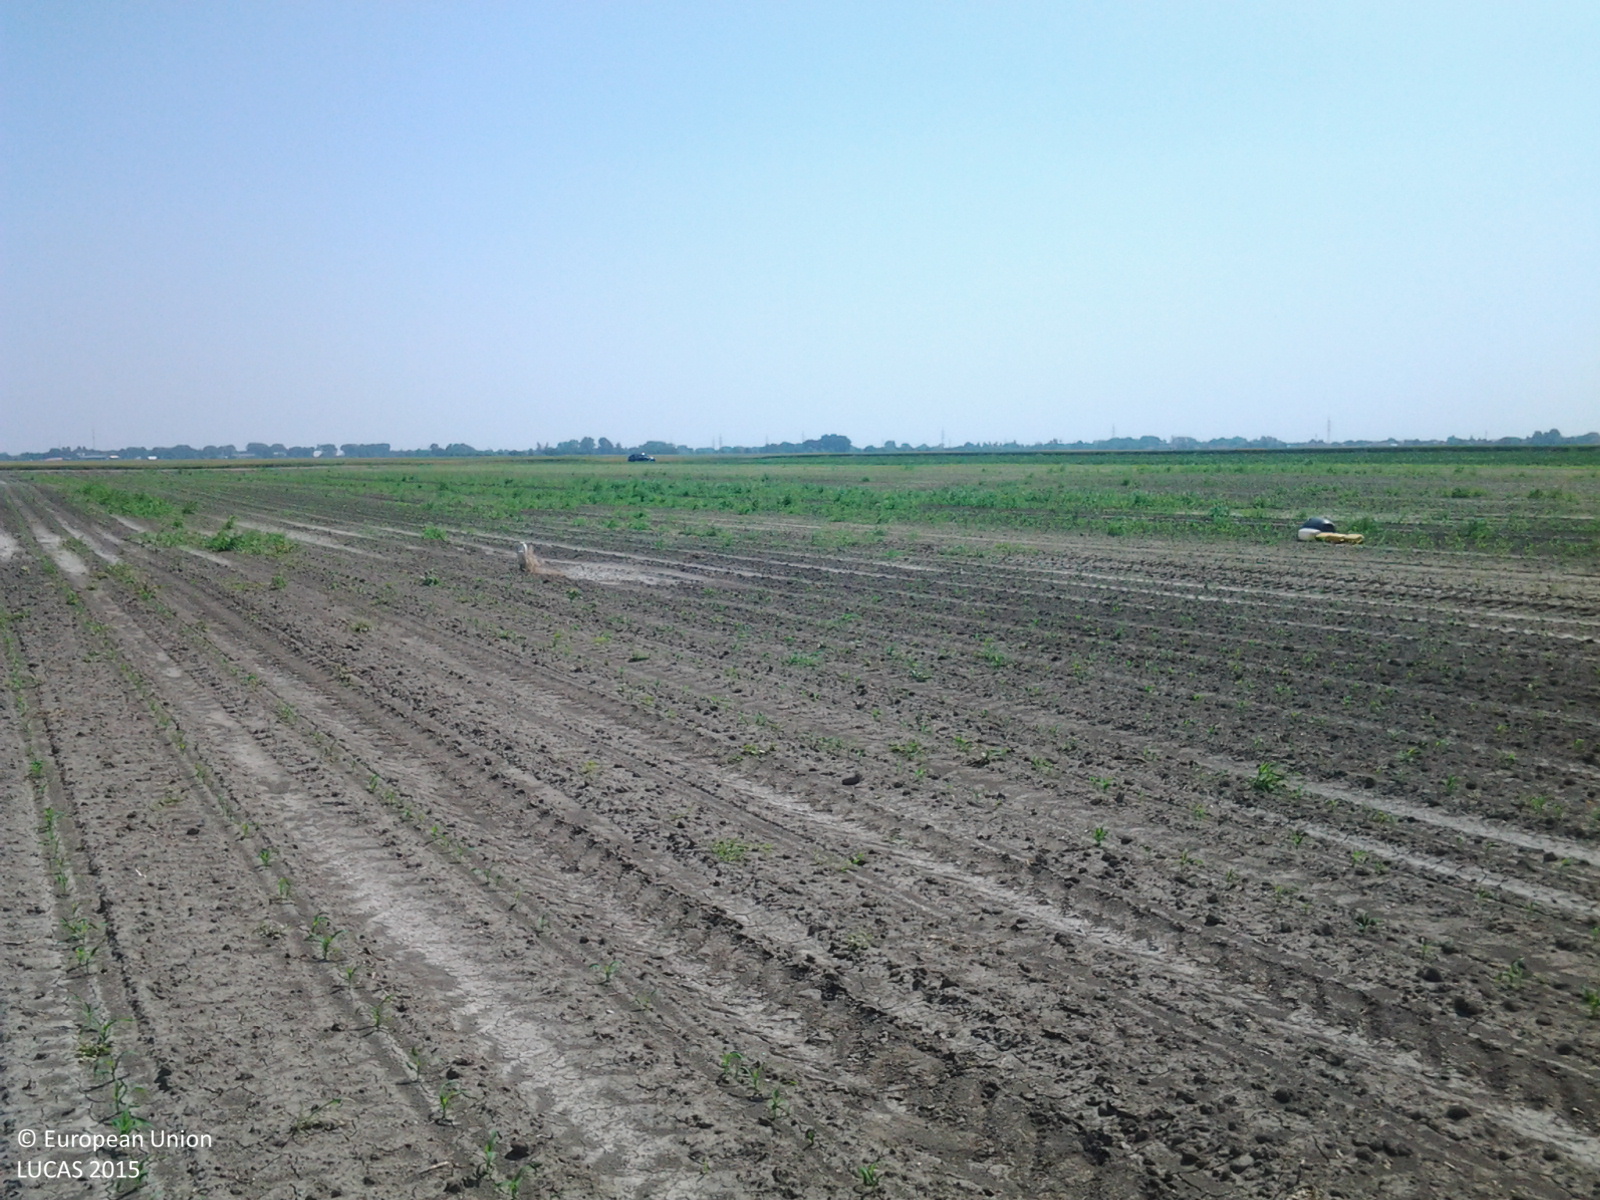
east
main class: Cropland
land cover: Maize
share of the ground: > 75 %
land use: Agriculture (excluding fallow land and kitchen gardens)
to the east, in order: Maize; Soya; Rye
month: June
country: HU
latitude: 46.5017
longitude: 18.9392
